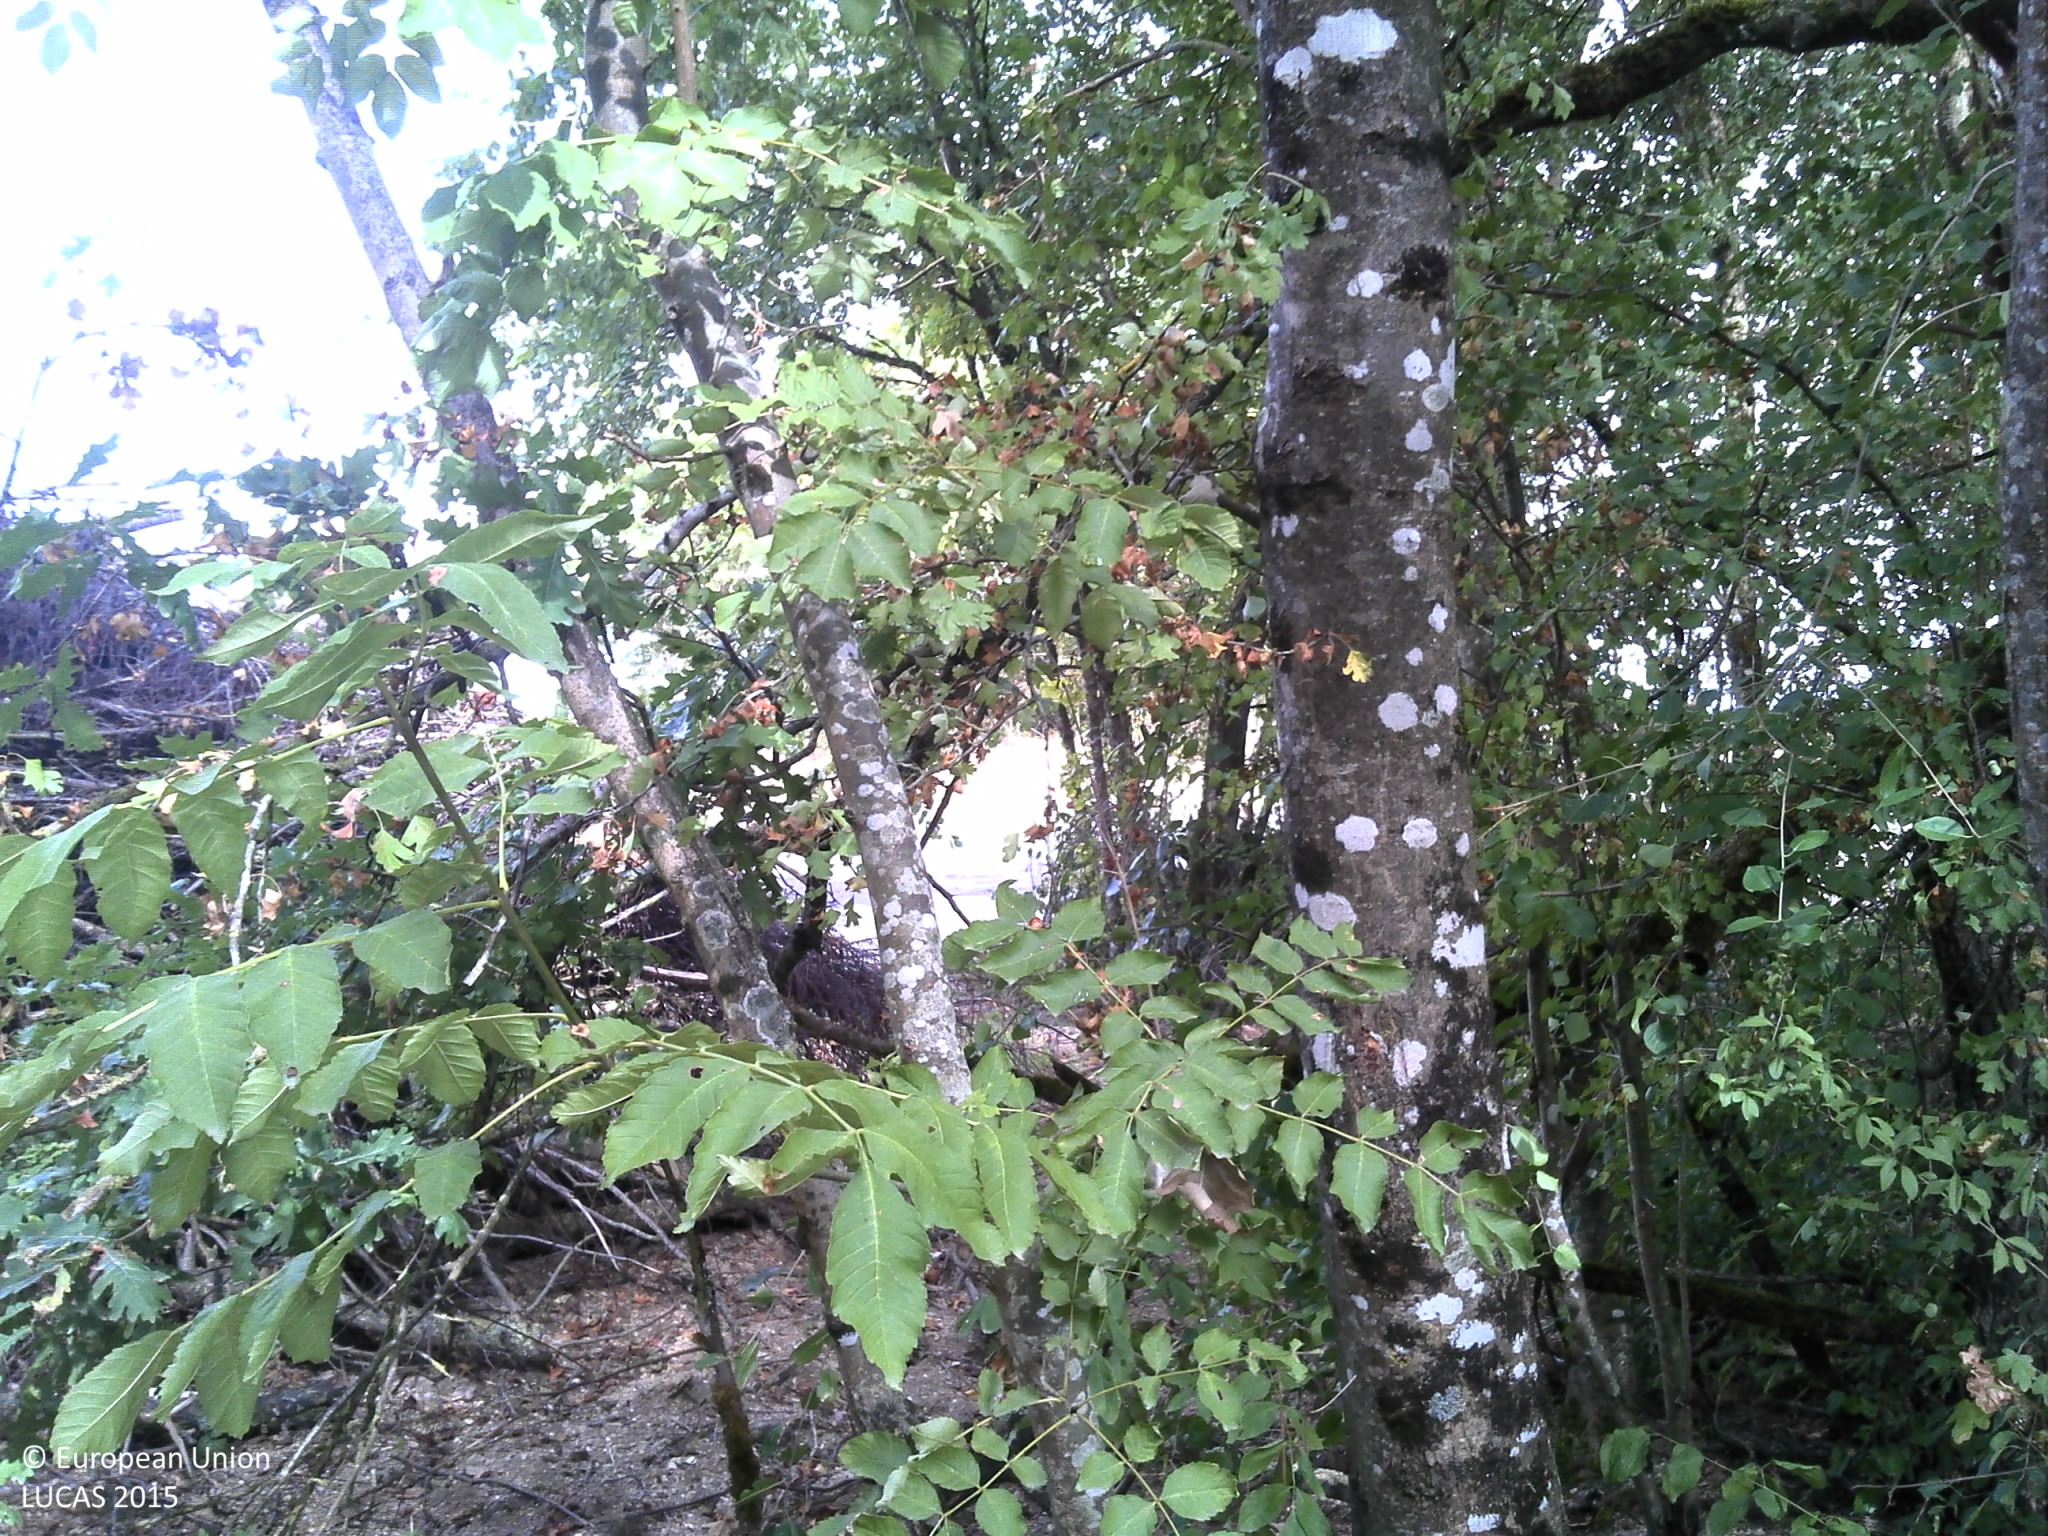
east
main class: Grassland
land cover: Grassland without tree/shrub cover
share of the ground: > 75 %
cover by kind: herbaceous plants 100 %
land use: Amenities, museums, leisure
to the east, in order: Grassland without tree/shrub cover; Broadleaved woodland; Fences; Broadleaved woodland; Artificial constructions in urban areas; Broadleaved woodland; Grassland without tree/shrub cover; Electric lines; Grass margins; Paved roads, cycling and walking lanes; Grassland without tree/shrub cover; Tracks; Other bare soil
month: August
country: FR
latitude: 48.5406
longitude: 4.2129
